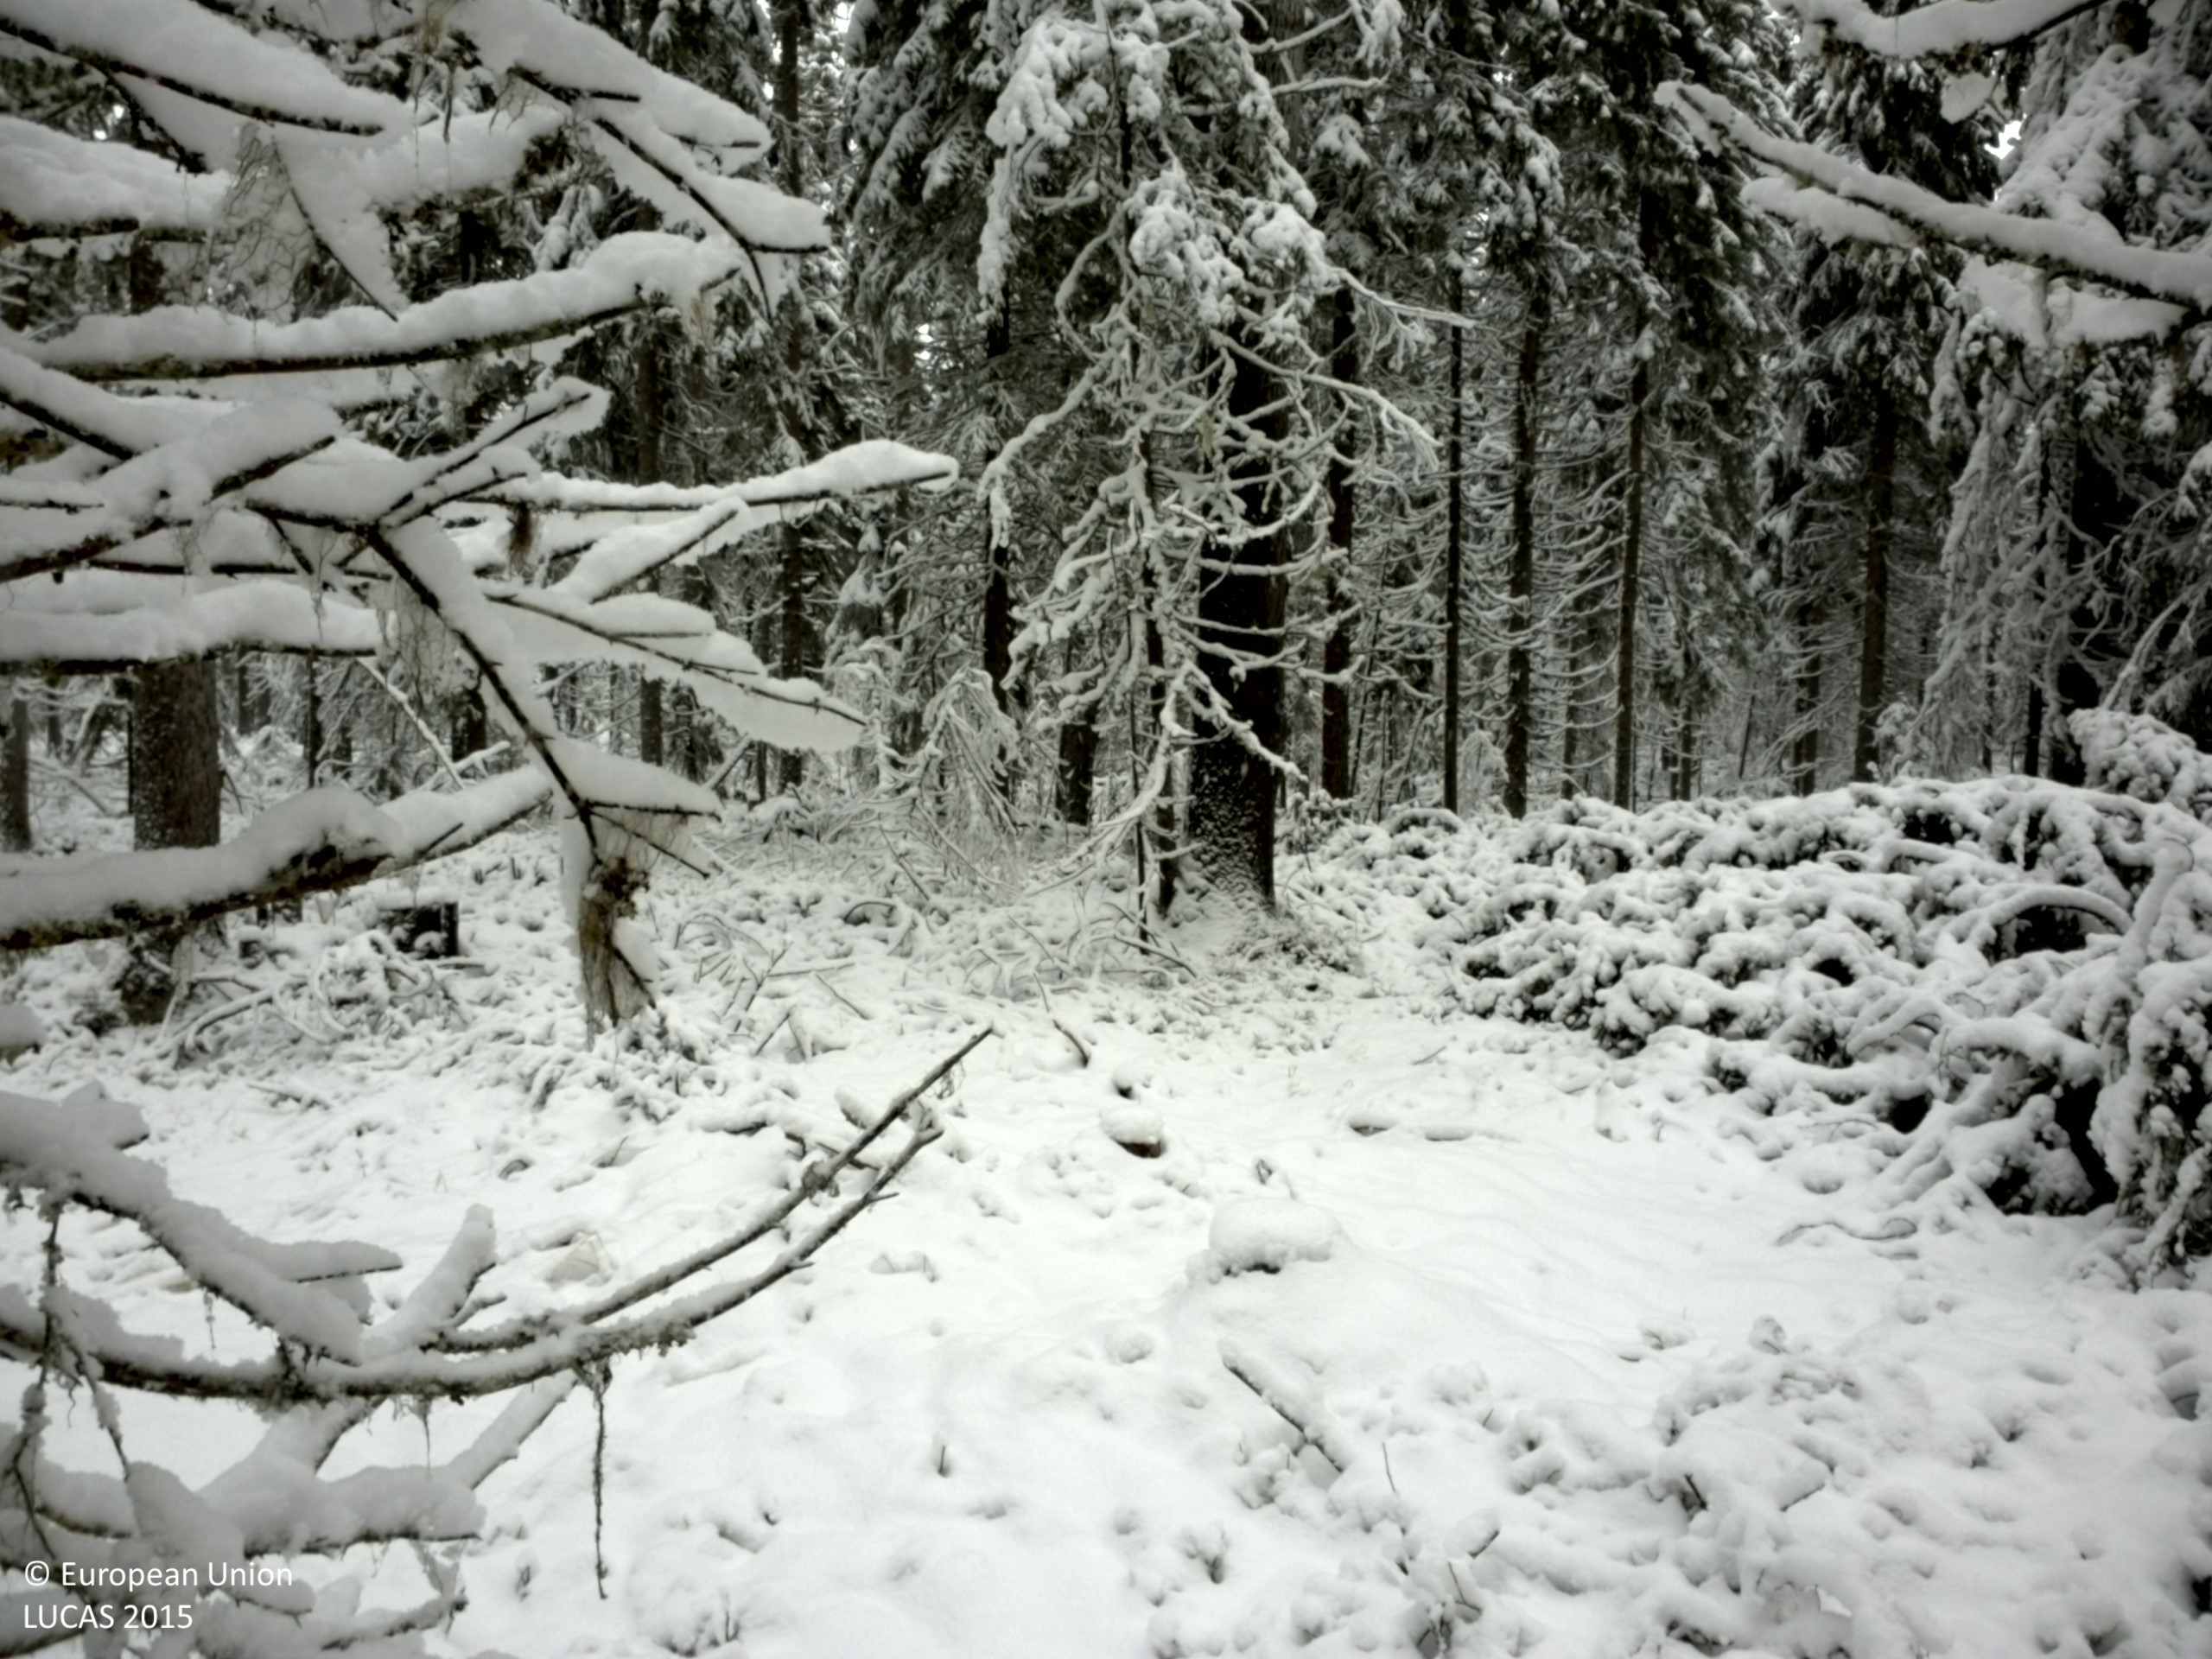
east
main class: Woodland
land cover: Spruce dominated coniferous woodland
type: boreal forest
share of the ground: > 75 %
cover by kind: coniferous forest trees 70 %, shrubs 15 %, lichens and mosses 10 %, broadleaved forest trees 5 %
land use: Forestry
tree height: > 5 m
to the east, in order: Spruce dominated coniferous woodland; Spruce dominated mixed woodland; Shrubland with sparse tree cover; Spruce dominated mixed woodland; Broadleaved woodland
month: November
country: SE
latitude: 63.7430
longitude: 15.4645
